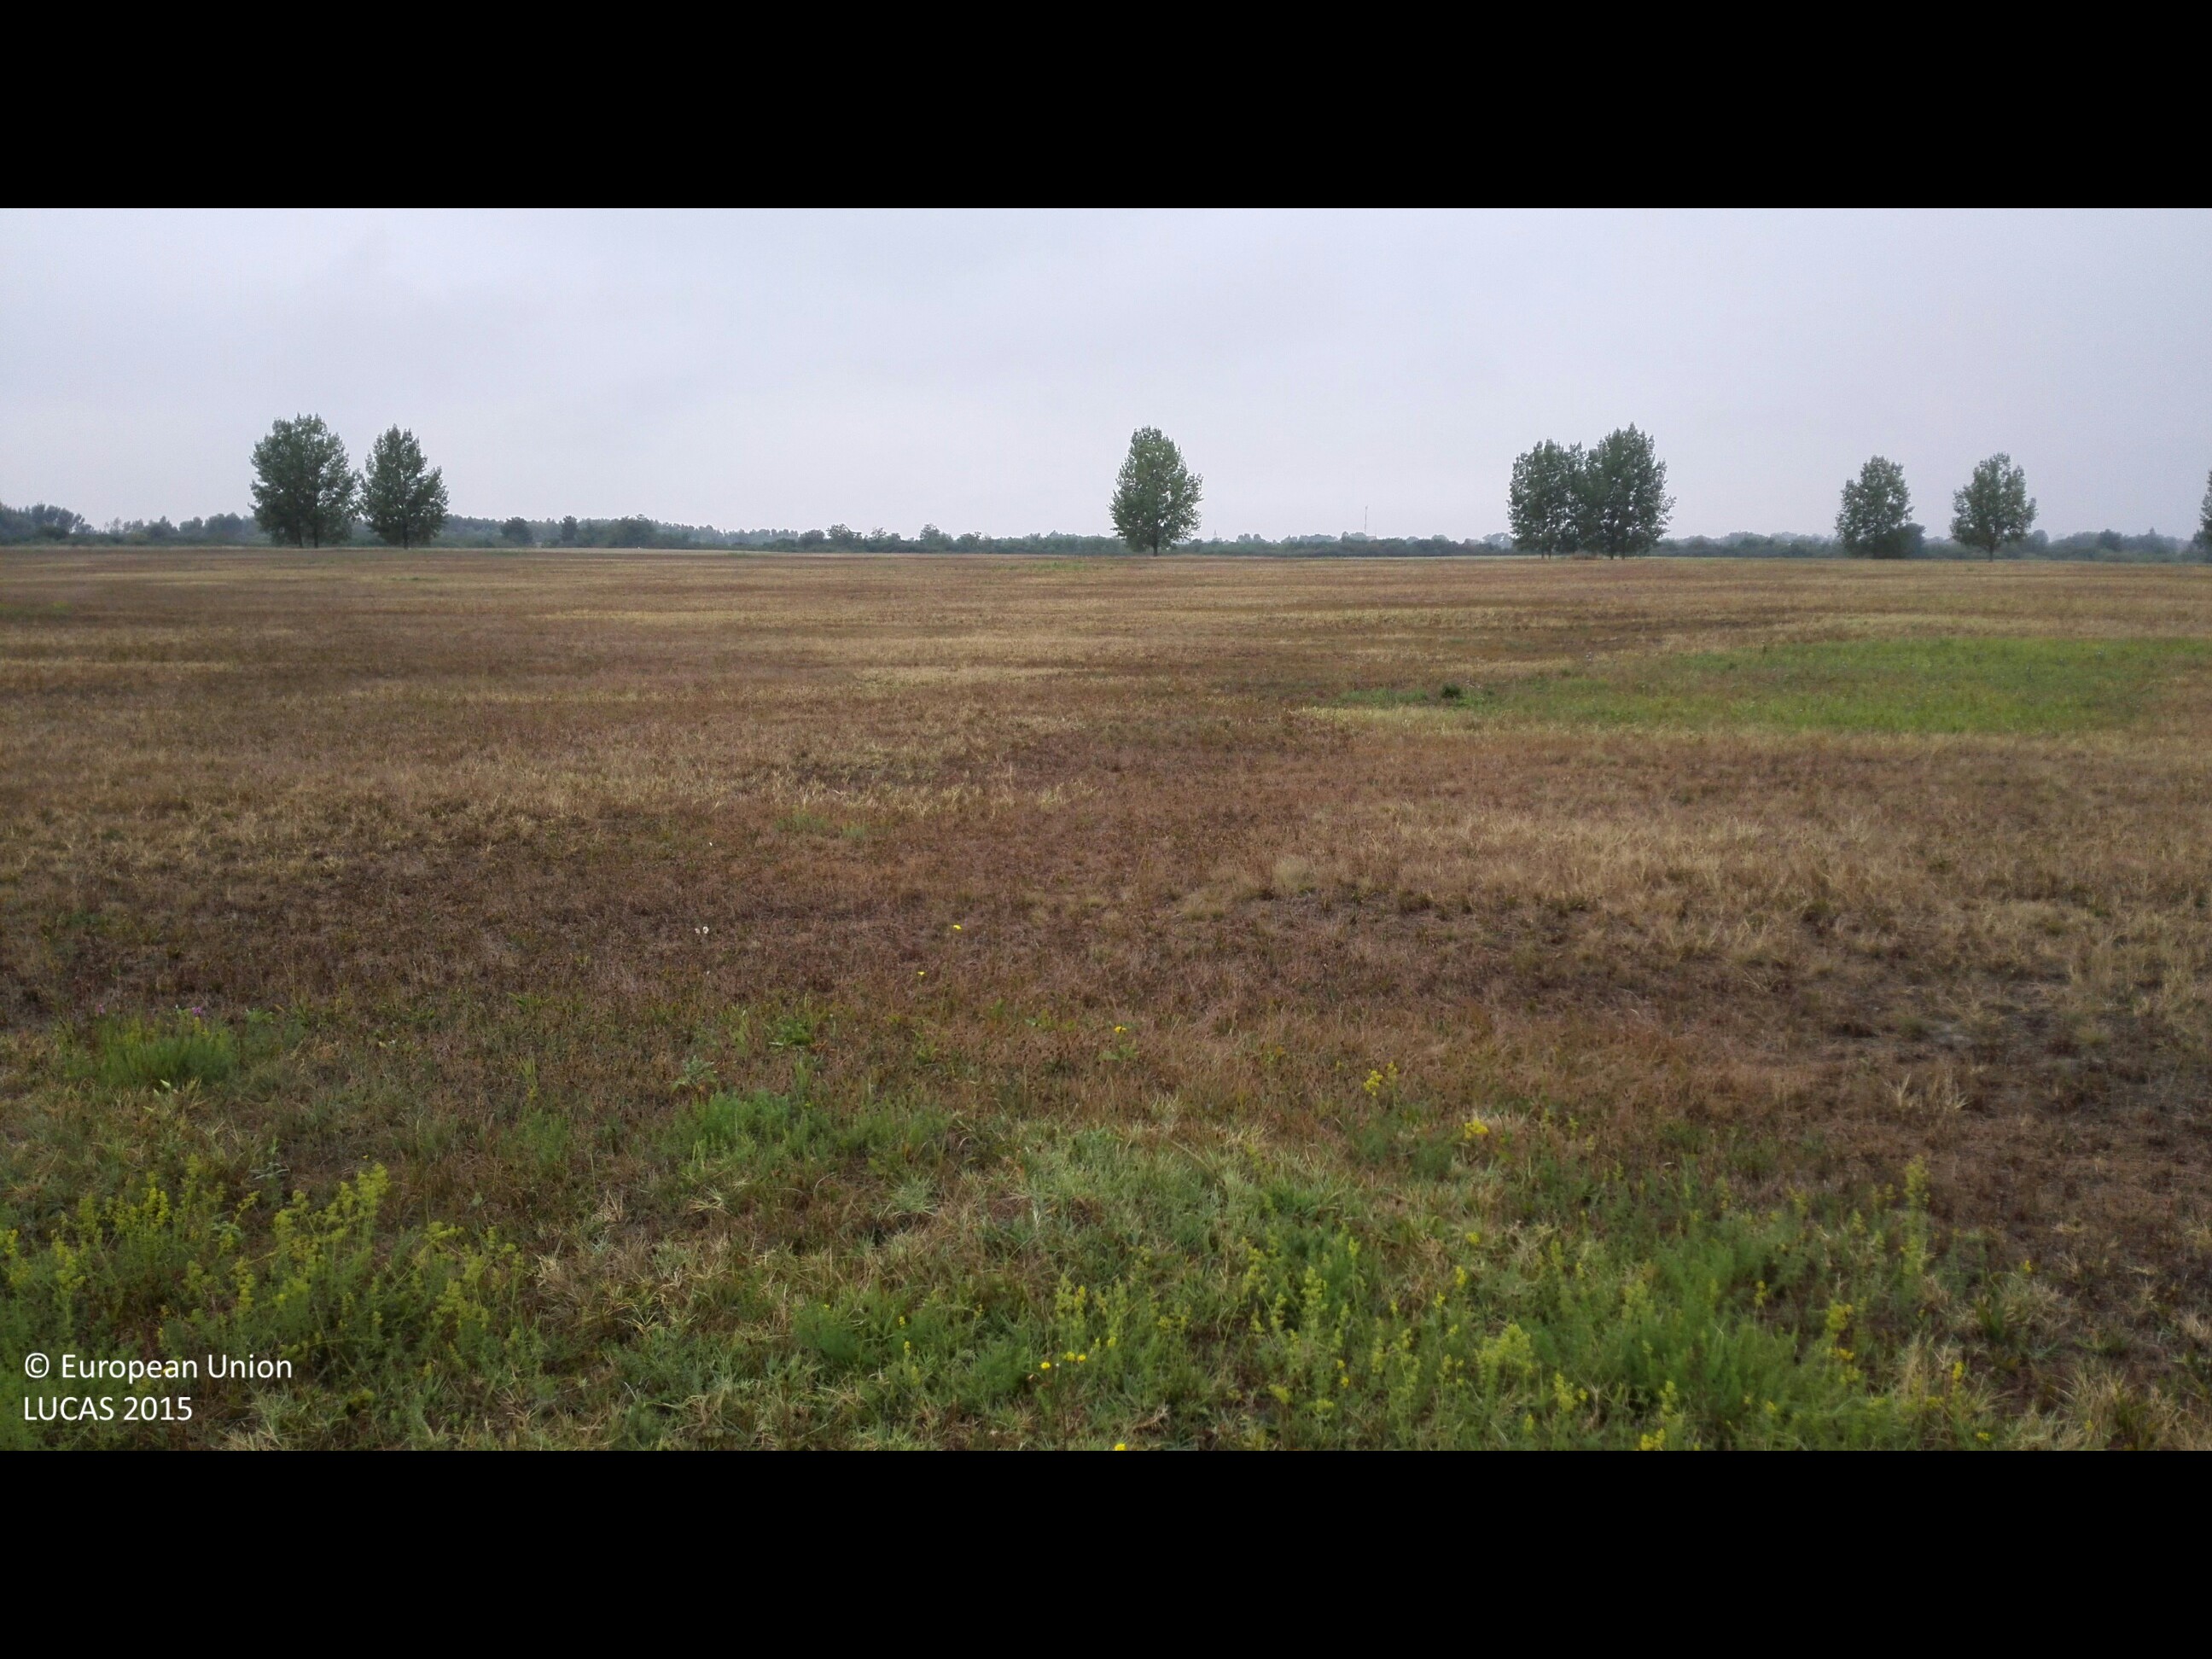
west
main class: Grassland
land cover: Grassland without tree/shrub cover
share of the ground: > 75 %
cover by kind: herbaceous plants 100 %
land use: Agriculture (excluding fallow land and kitchen gardens)
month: August
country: HU
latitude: 47.2755
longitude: 21.8242
